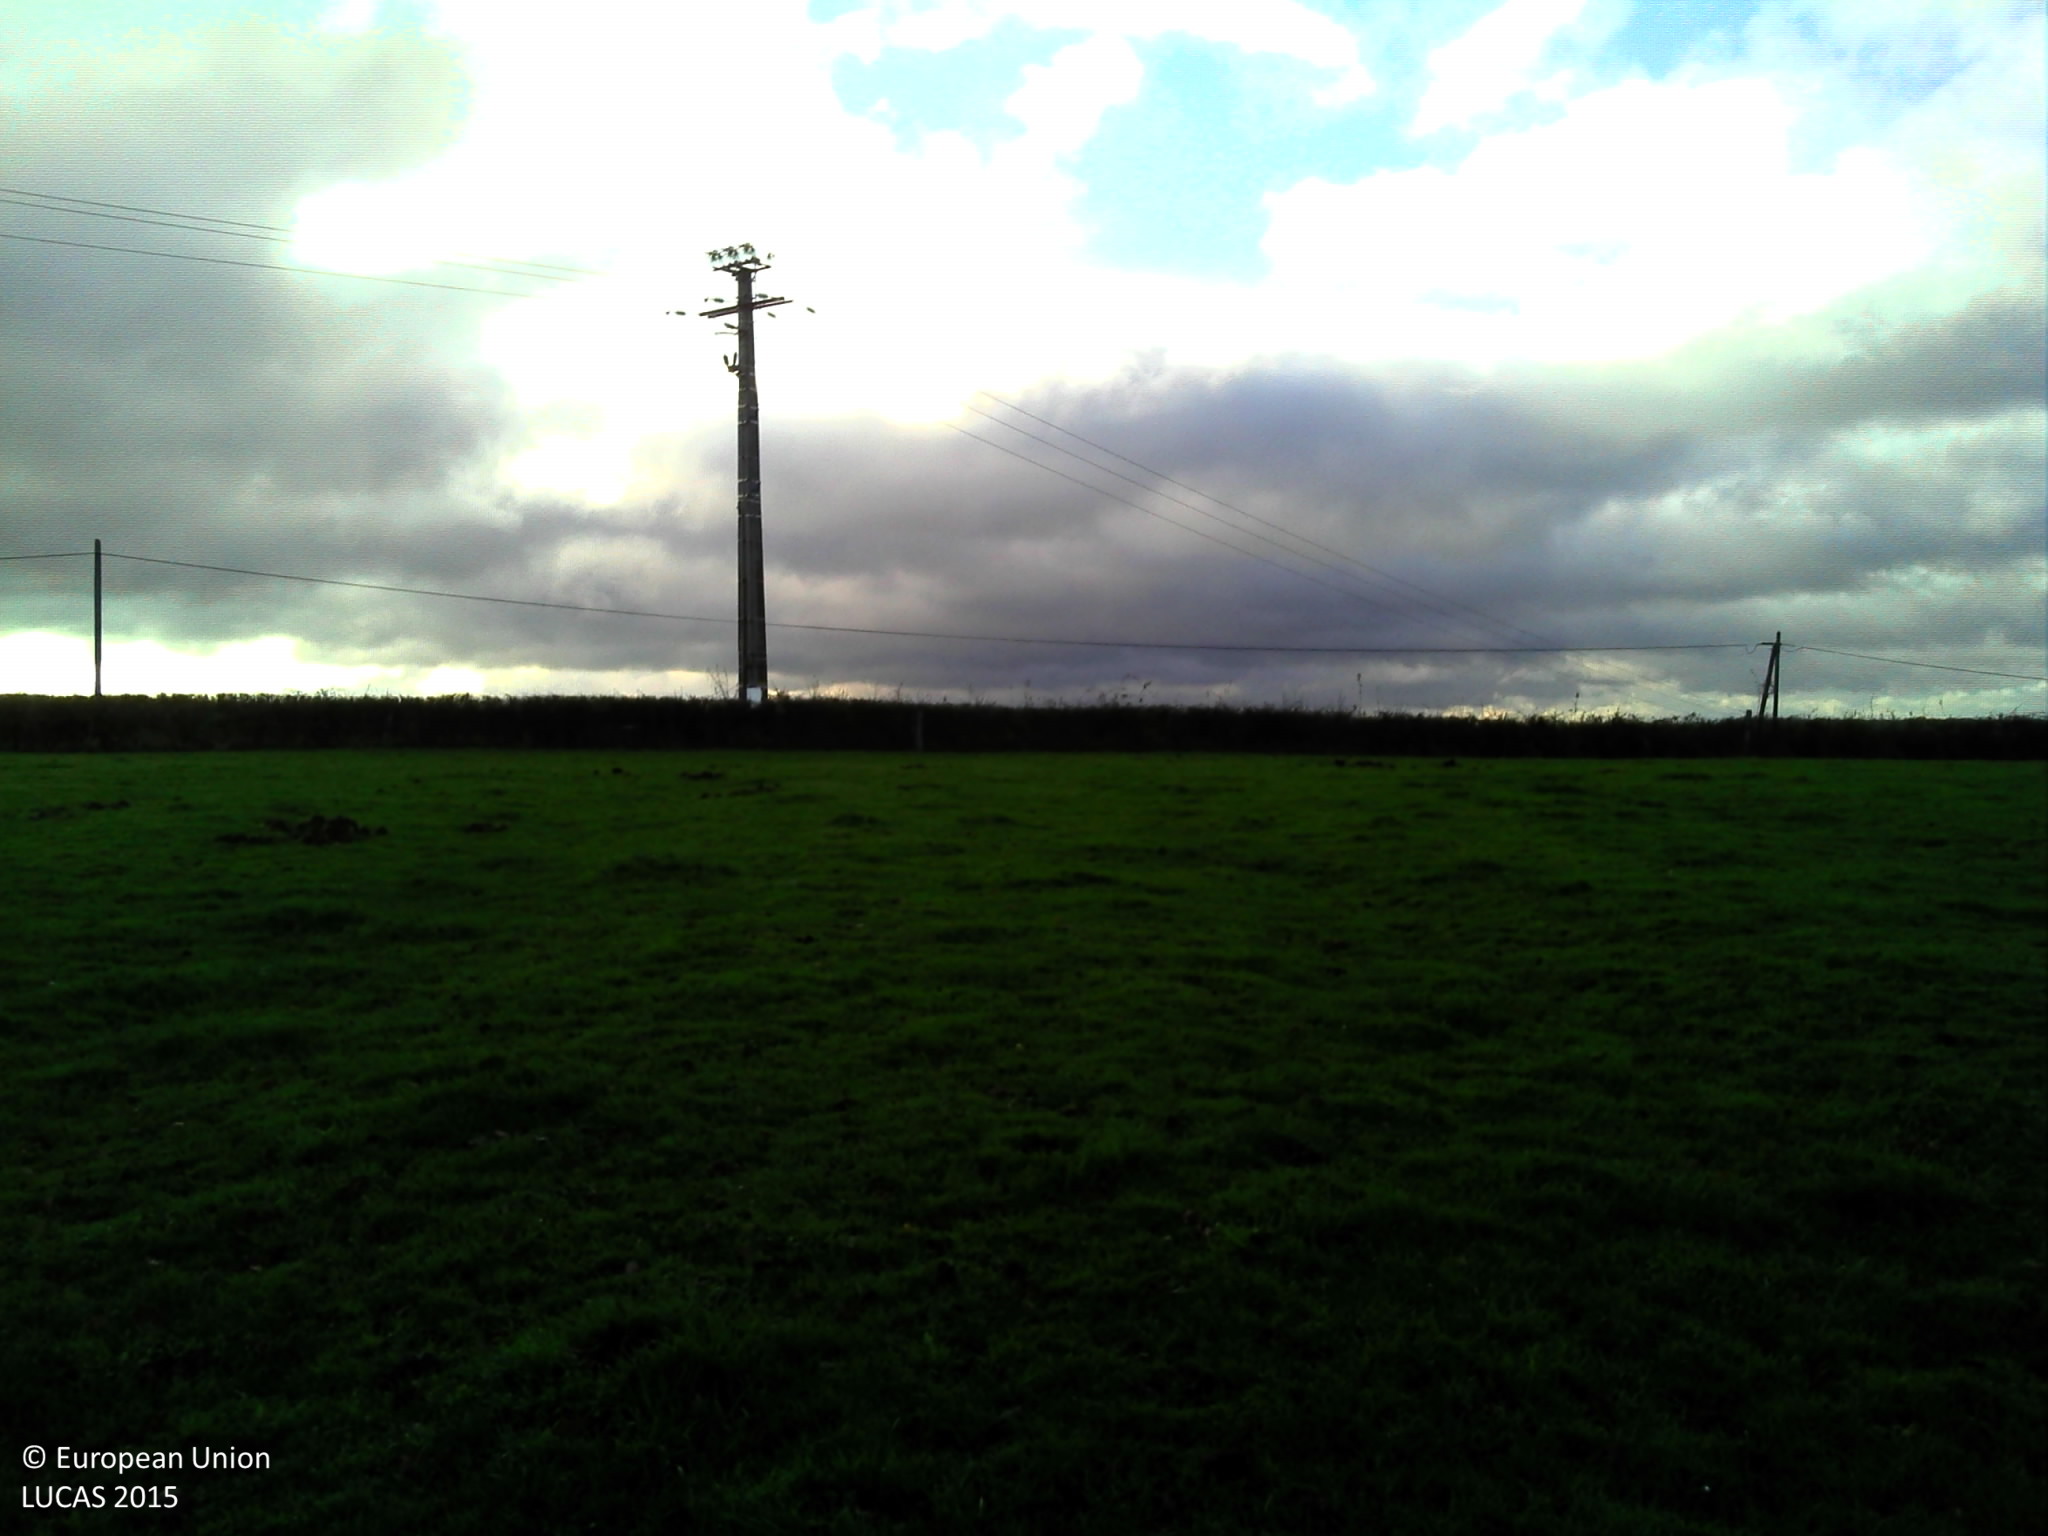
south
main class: Grassland
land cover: Grassland without tree/shrub cover
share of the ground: > 75 %
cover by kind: herbaceous plants 100 %
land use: Agriculture (excluding fallow land and kitchen gardens)
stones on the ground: < 10 %
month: August
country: FR
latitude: 46.4521
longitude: 3.6593
